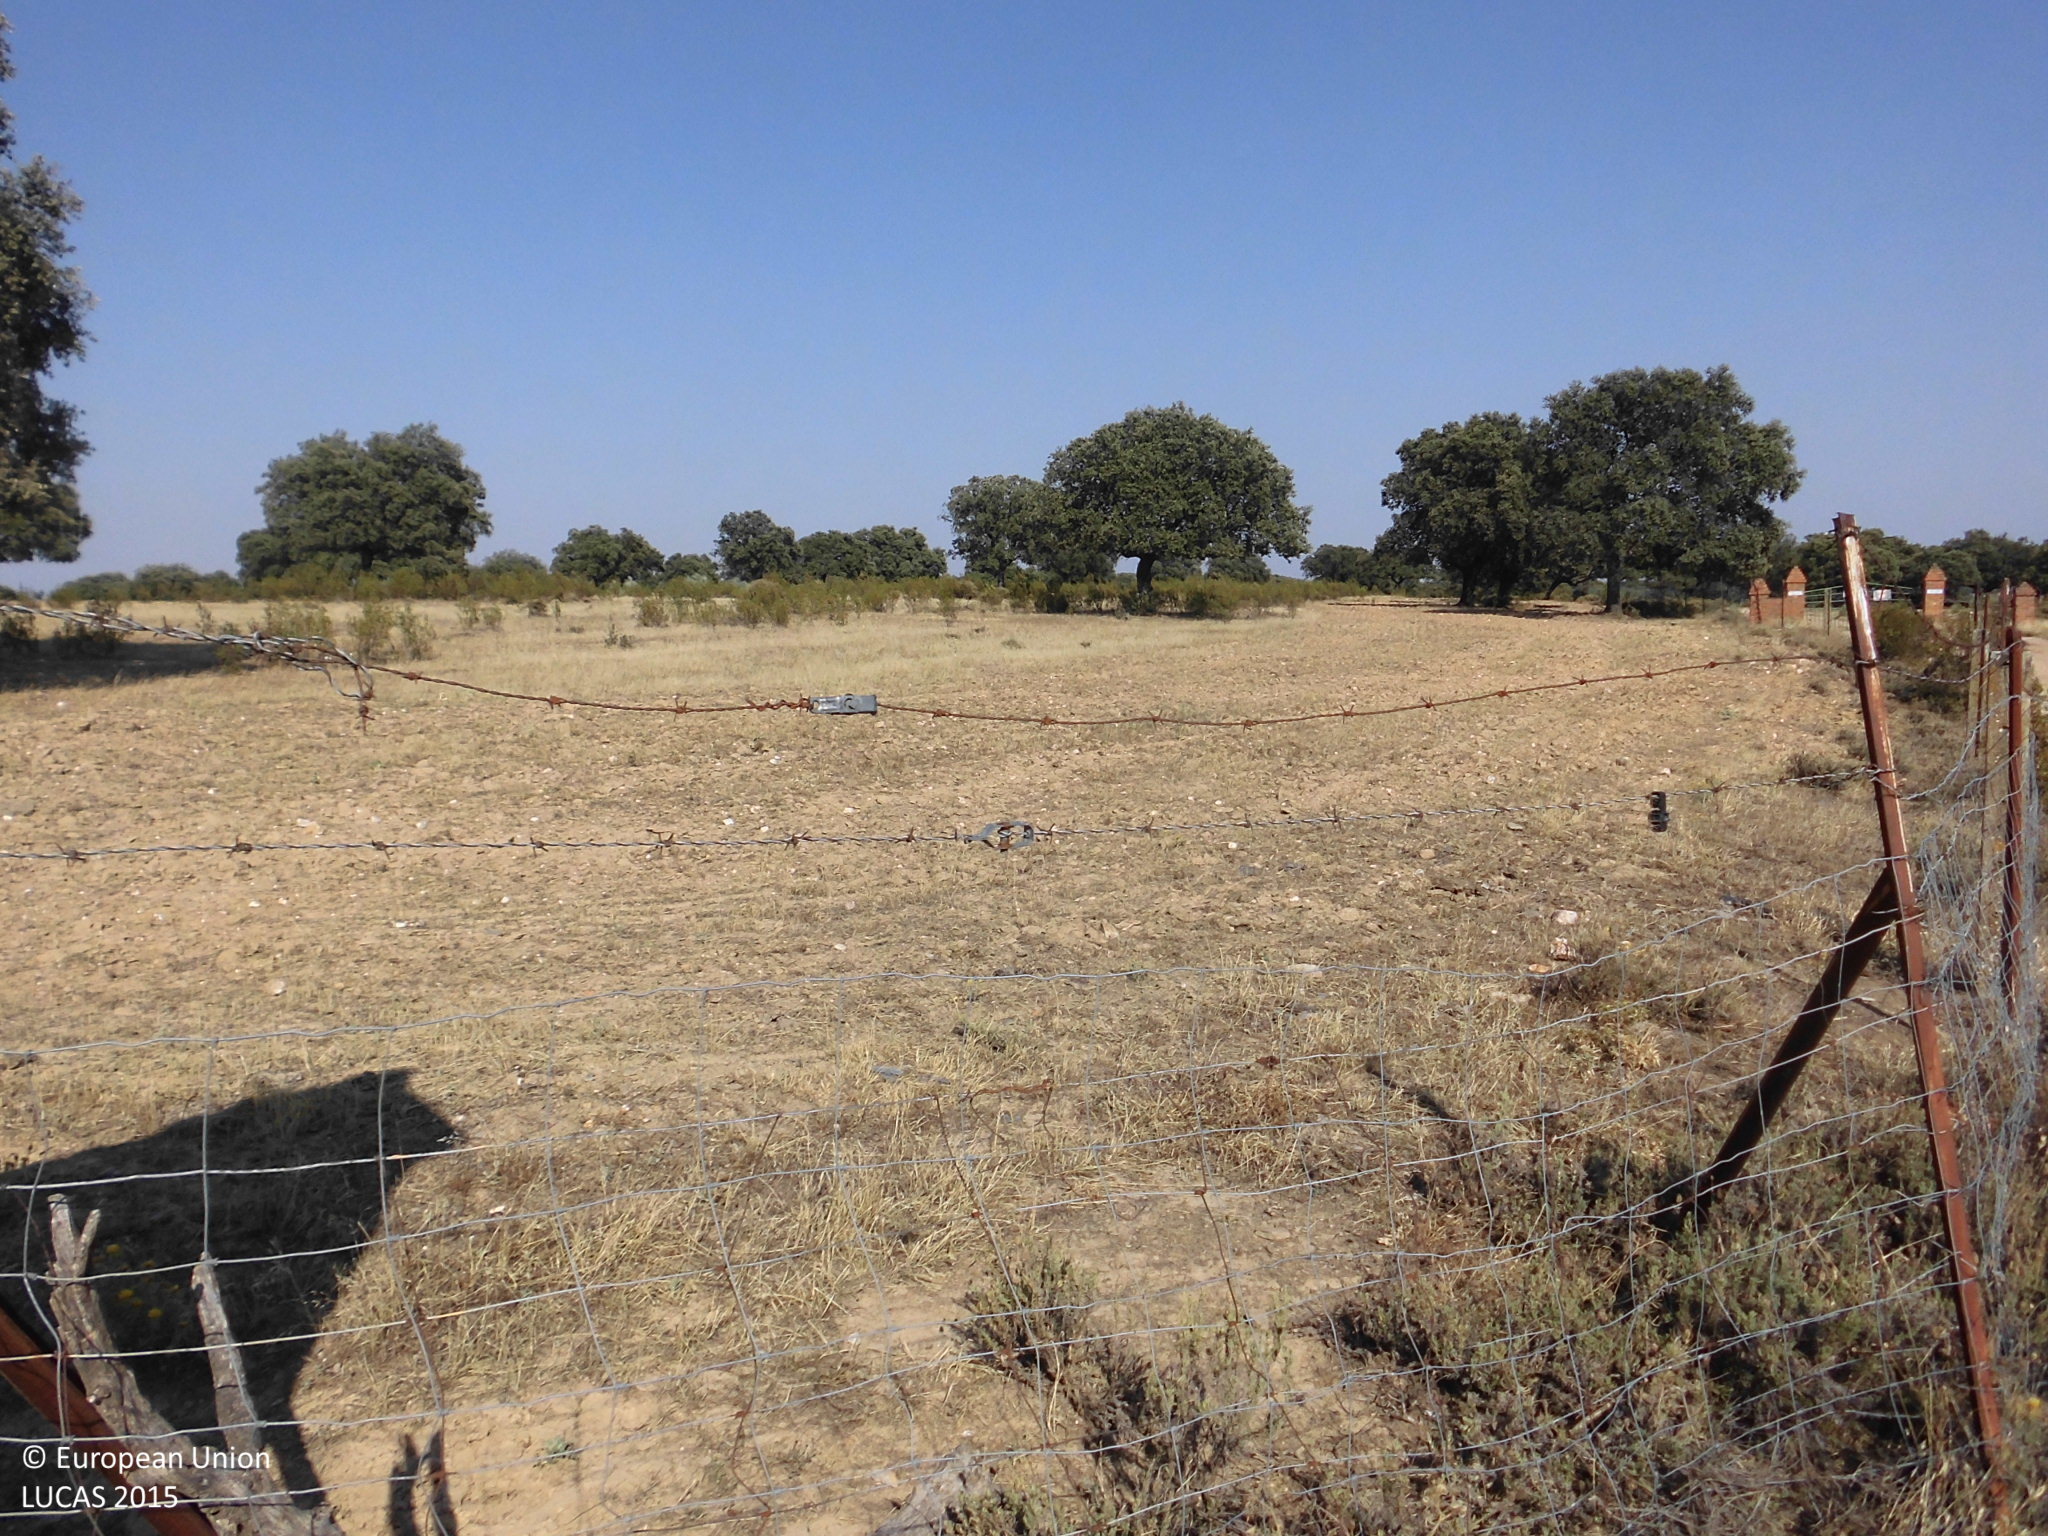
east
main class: Woodland
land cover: Broadleaved woodland
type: broadleaved evergreen forest
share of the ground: 25 - 50 %
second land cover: Shrubland without tree cover
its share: > 75 %
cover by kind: herbaceous plants 50 %, broadleaved forest trees 25 %, shrubs 25 %
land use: Forestry
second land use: Agriculture (excluding fallow land and kitchen gardens)
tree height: > 5 m
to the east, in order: Broadleaved woodland; Shrubland without tree cover; Grassland without tree/shrub cover; Broadleaved woodland
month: June
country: ES
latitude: 39.9314
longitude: -6.0416
